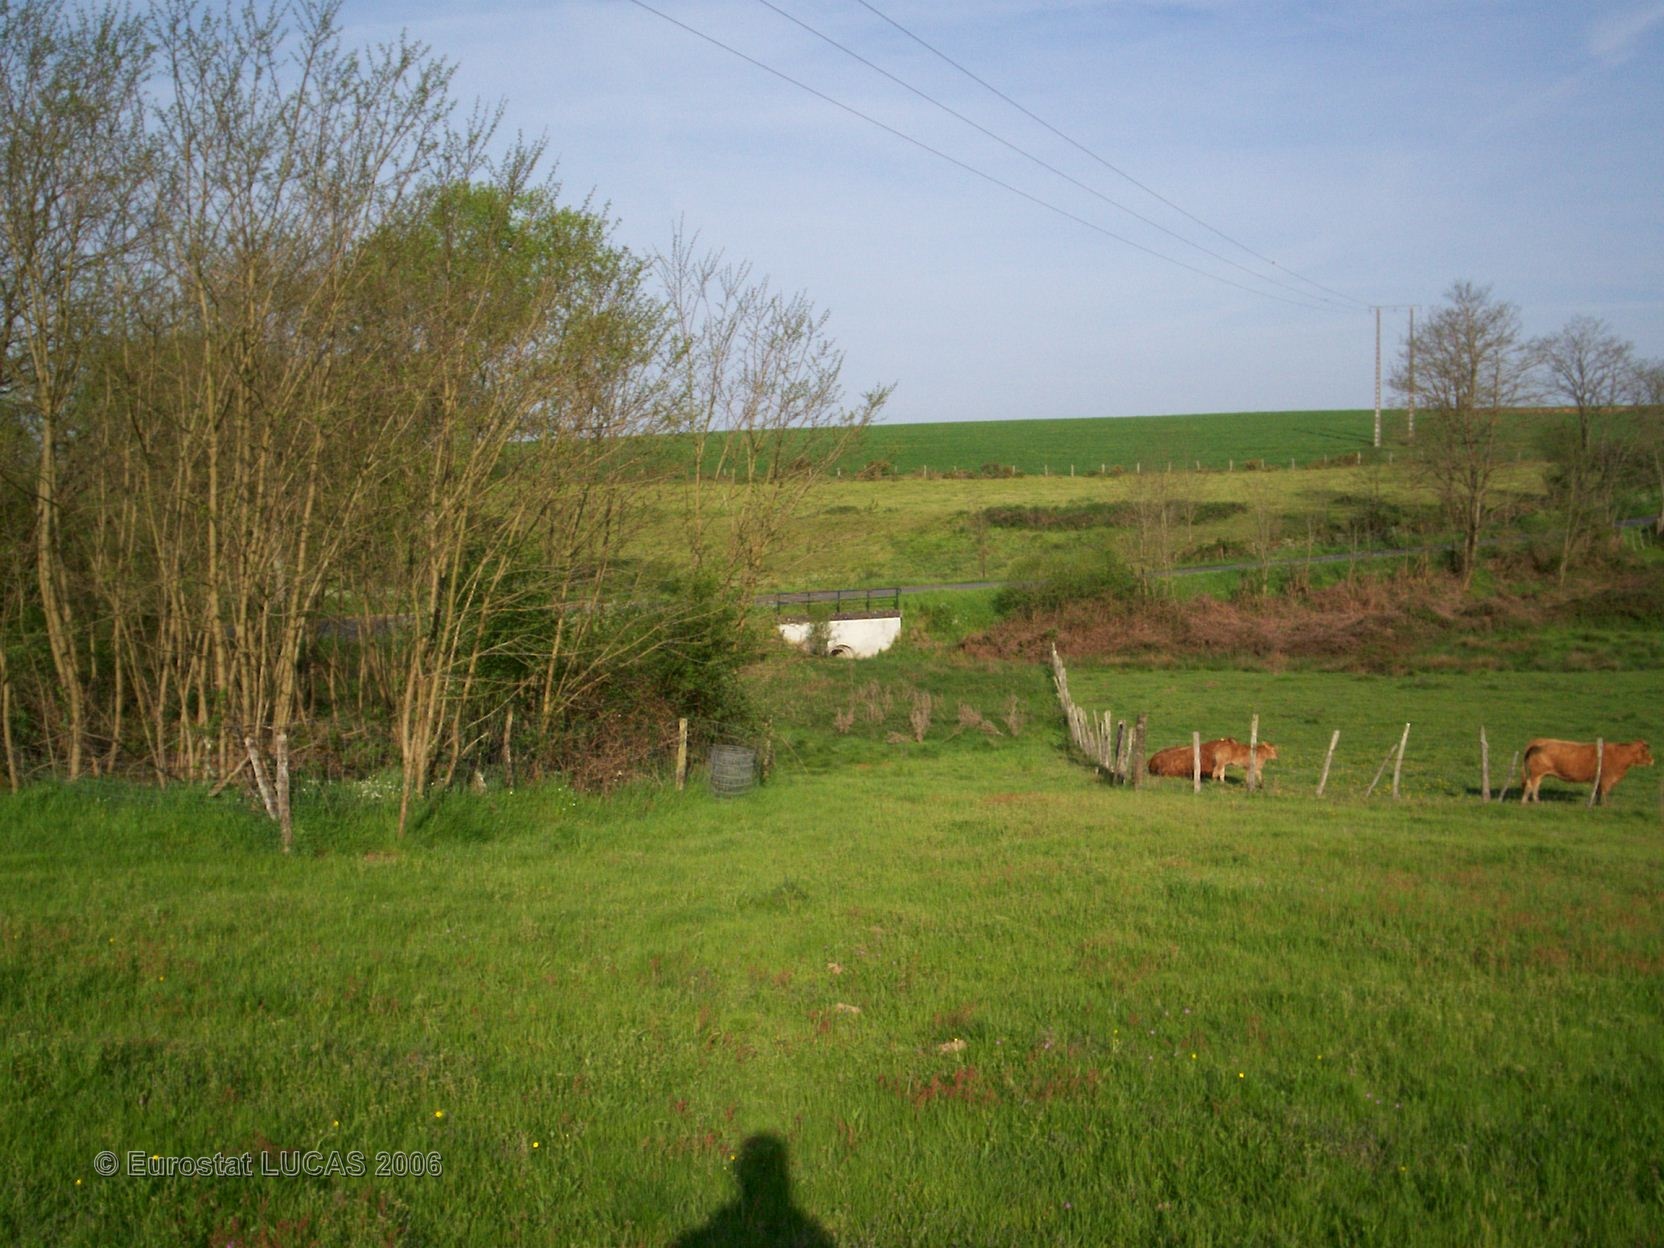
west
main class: Grassland
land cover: Grassland without tree/shrub cover
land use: Agriculture (excluding fallow land and kitchen gardens)
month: May
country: FR
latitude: 45.8905
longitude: 0.6951
